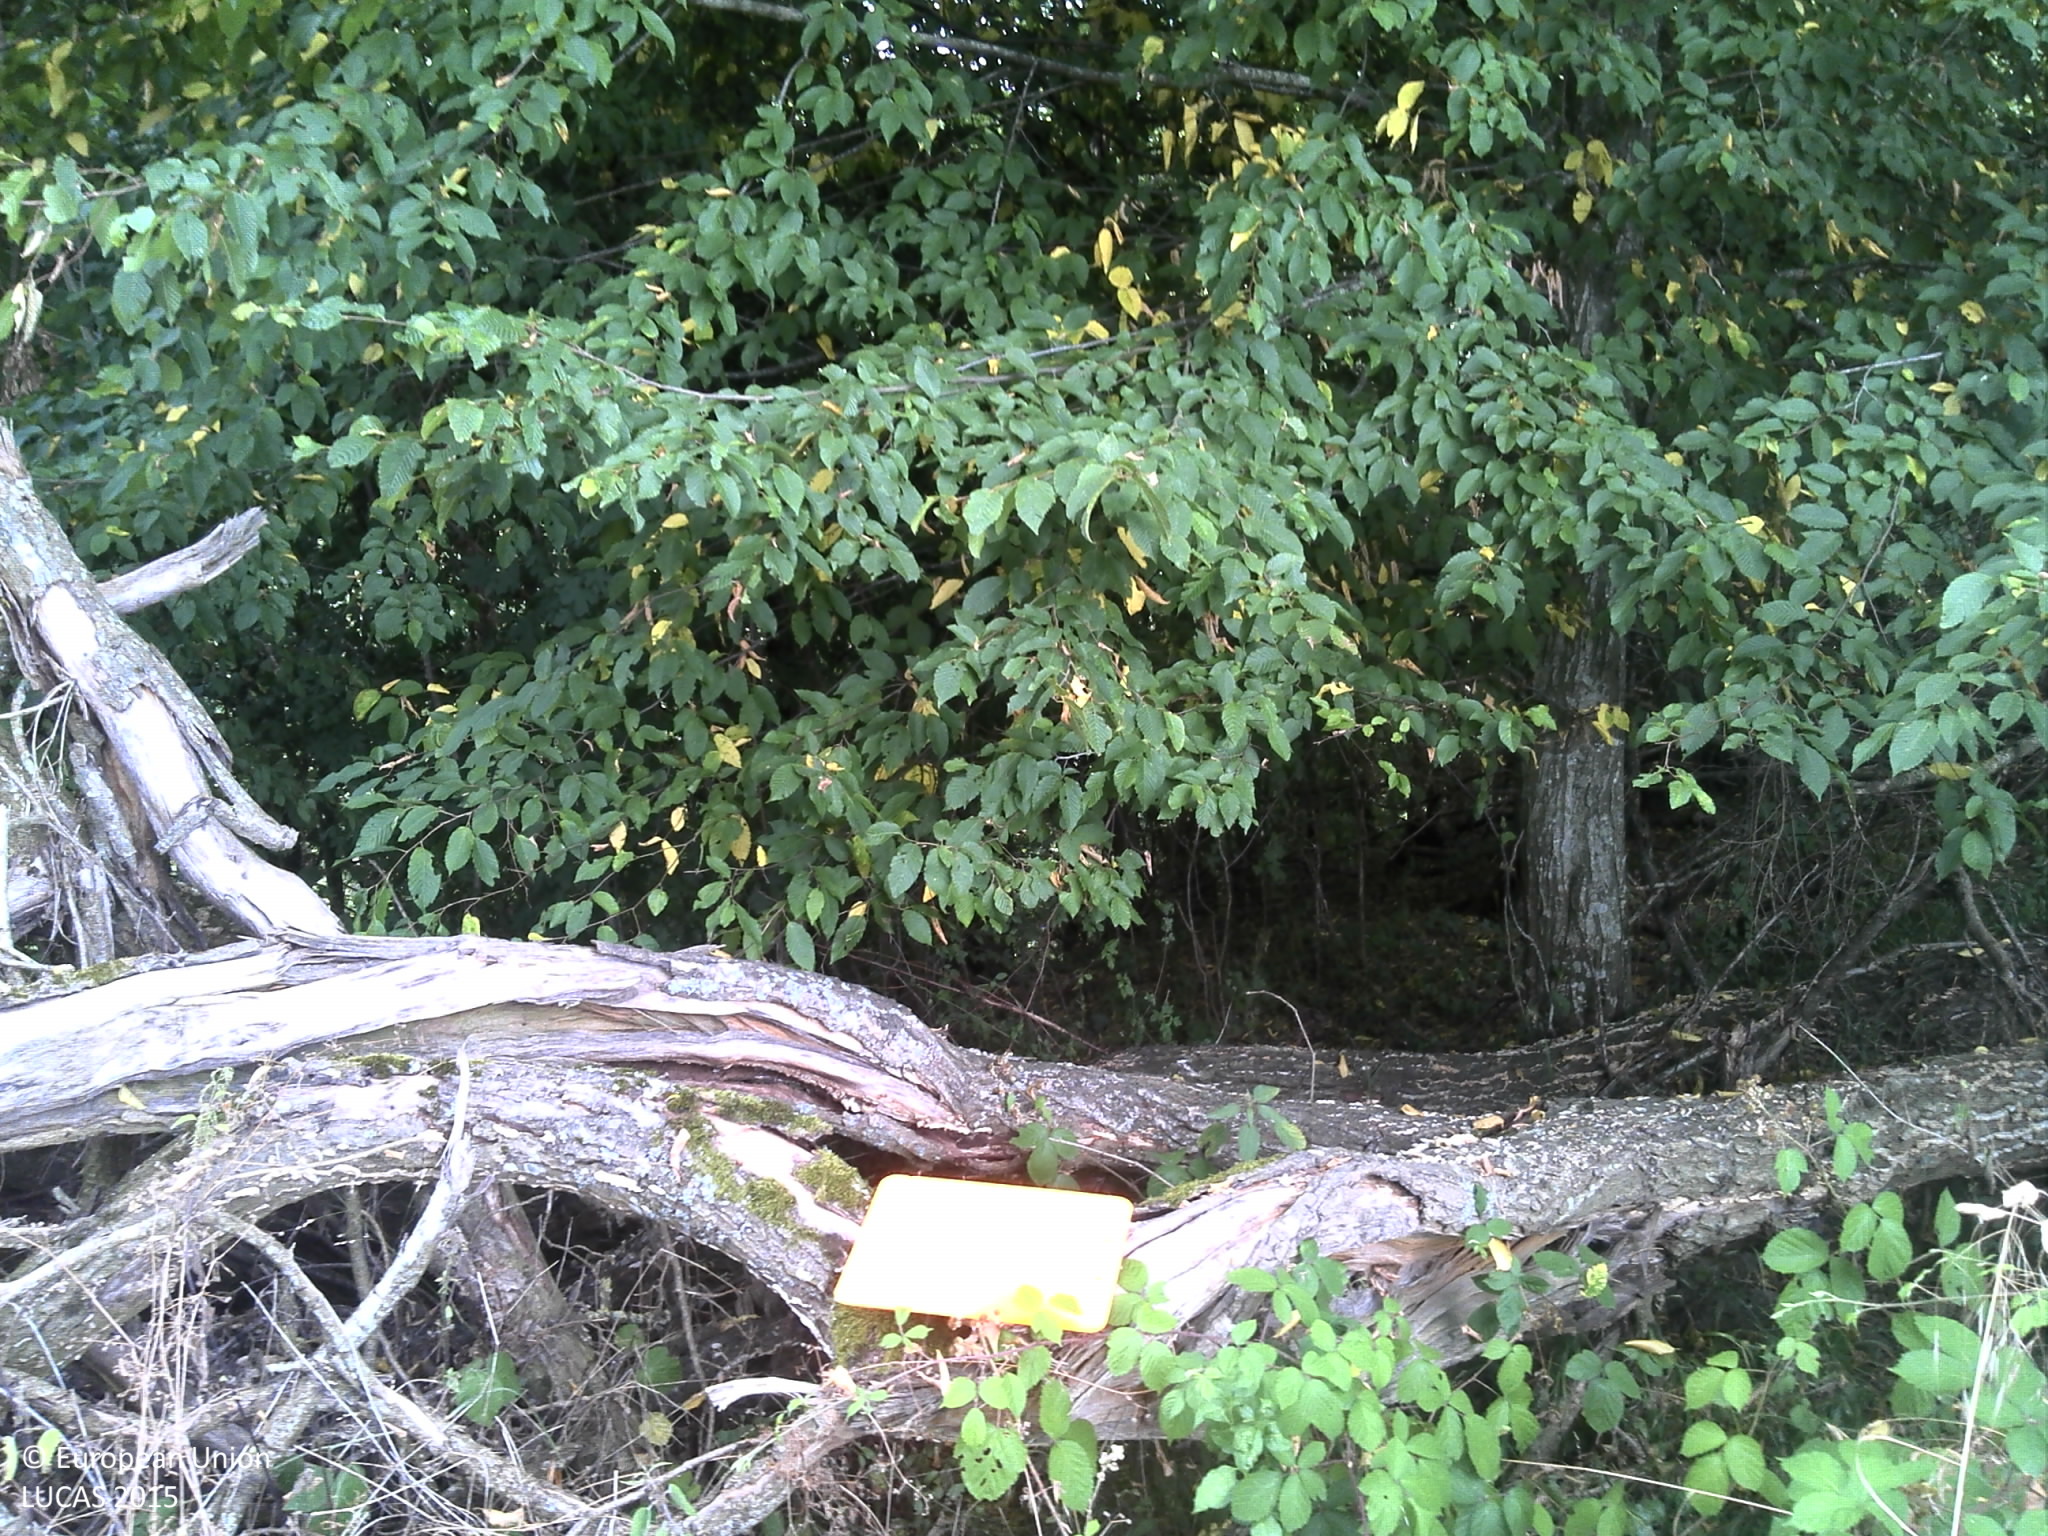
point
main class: Woodland
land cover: Broadleaved woodland
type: acidophilous oak and oak-birch forest
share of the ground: 50 - 75 %
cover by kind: broadleaved forest trees 70 %, herbaceous plants 20 %, consolidated bare surface 10 %
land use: Forestry
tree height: > 5 m
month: July
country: FR
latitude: 49.3259
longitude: 4.7824
